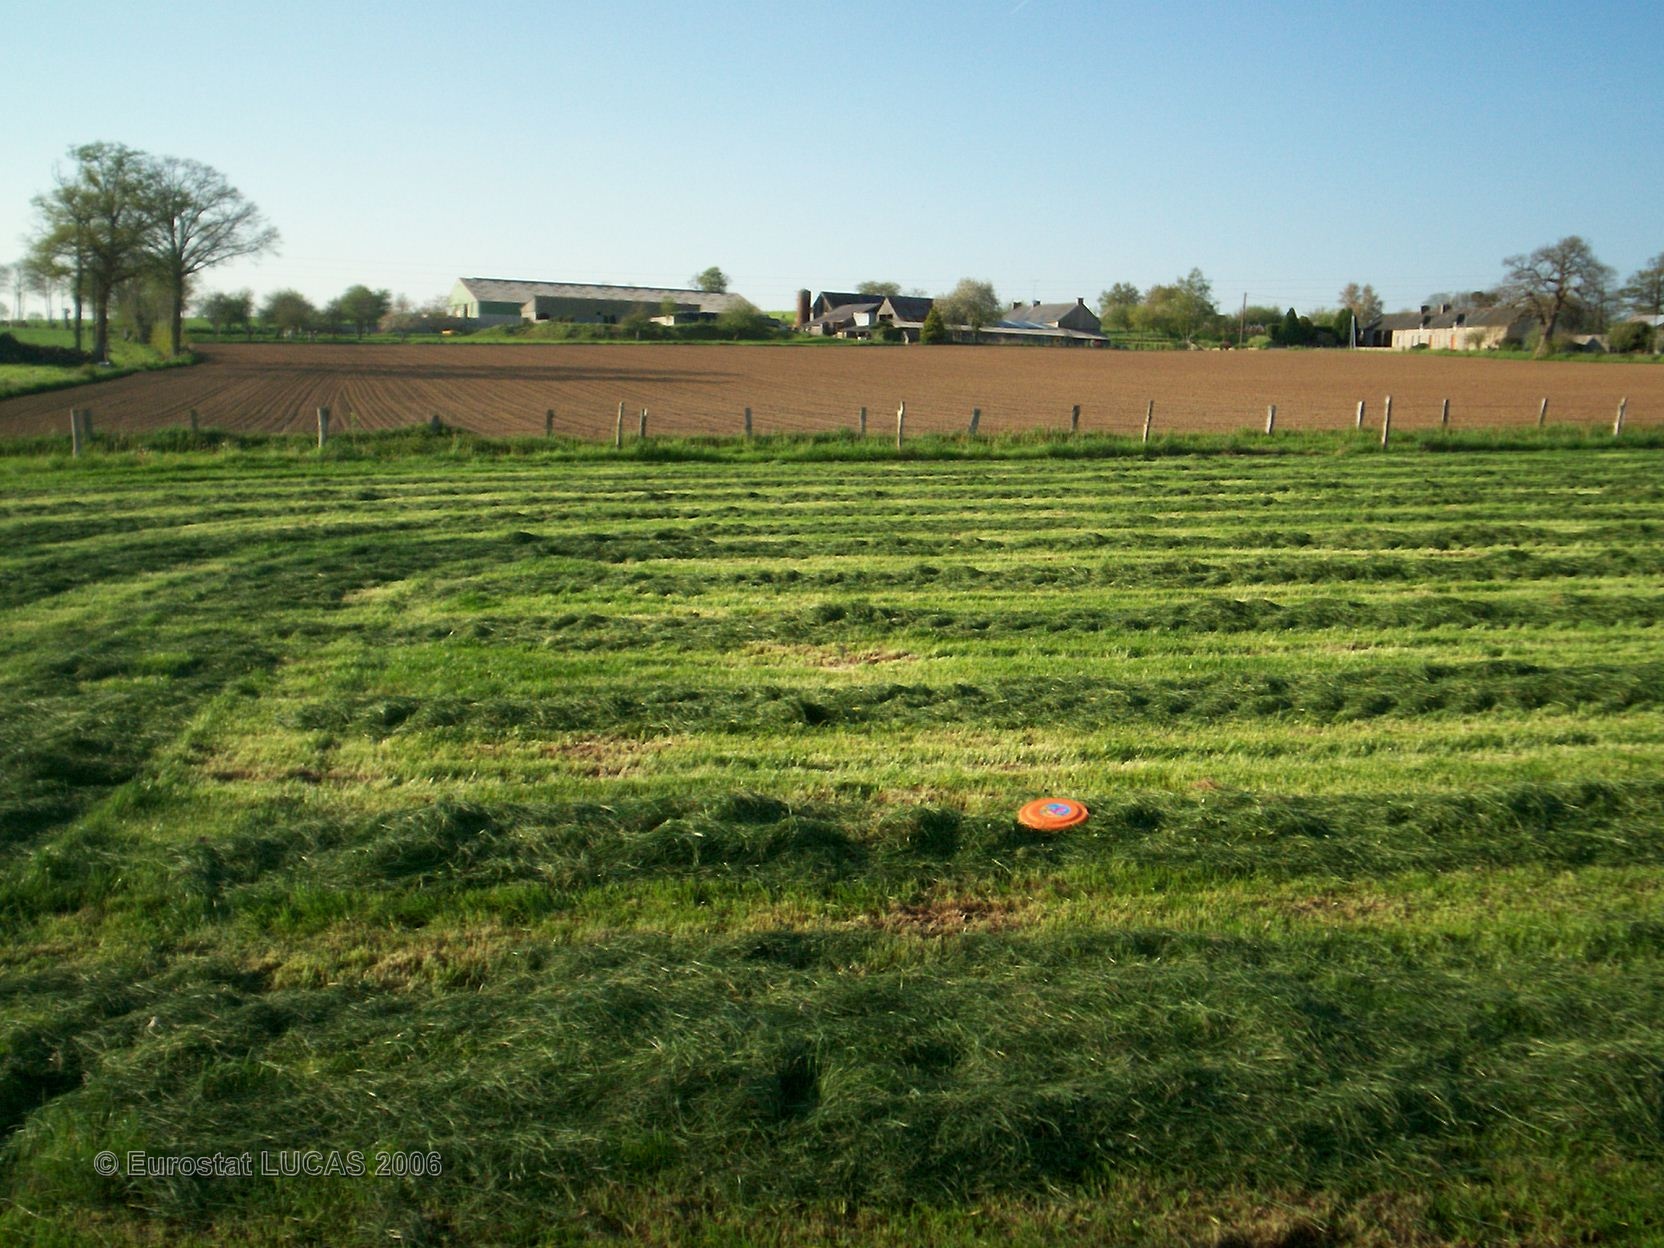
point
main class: Grassland
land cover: Grassland without tree/shrub cover
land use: Agriculture (excluding fallow land and kitchen gardens)
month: May
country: FR
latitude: 48.2523
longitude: -1.1803
